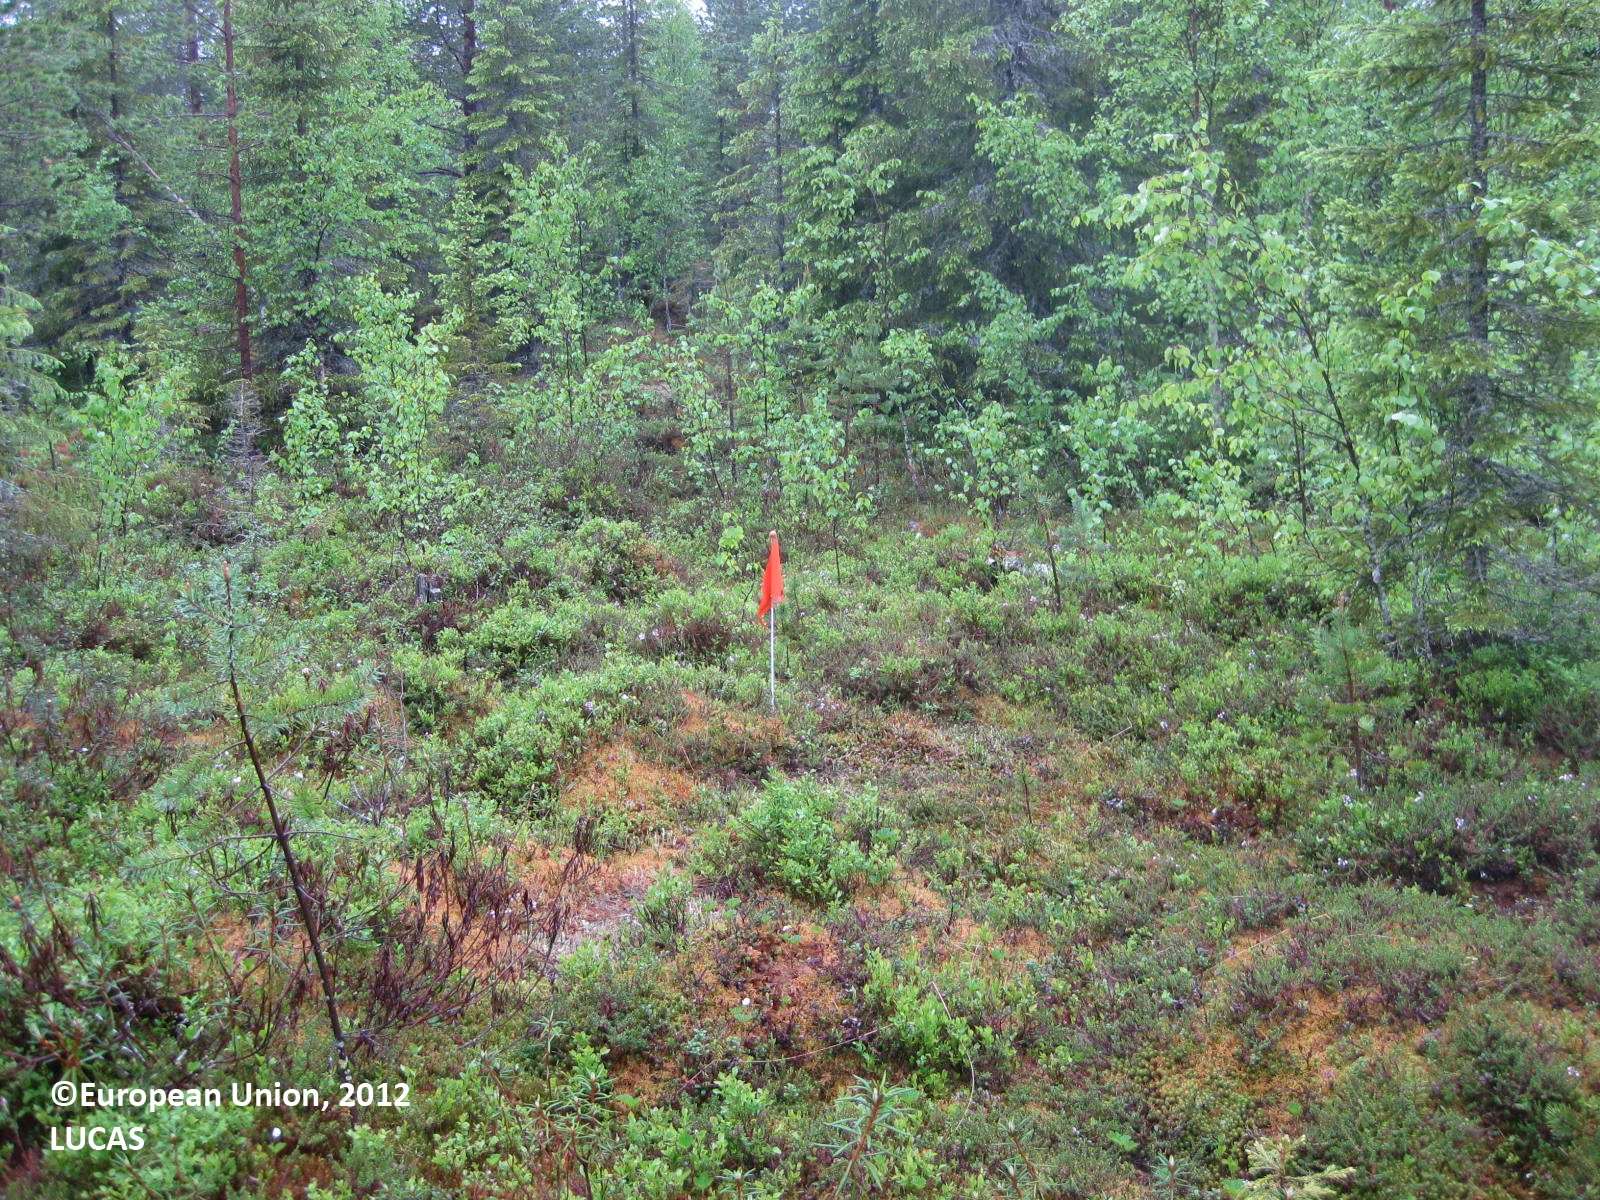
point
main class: Woodland
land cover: Other mixed woodland
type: boreal forest
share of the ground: 50 - 75 %
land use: Forestry
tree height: > 5 m
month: June
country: FI
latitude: 65.3449
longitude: 29.0240
